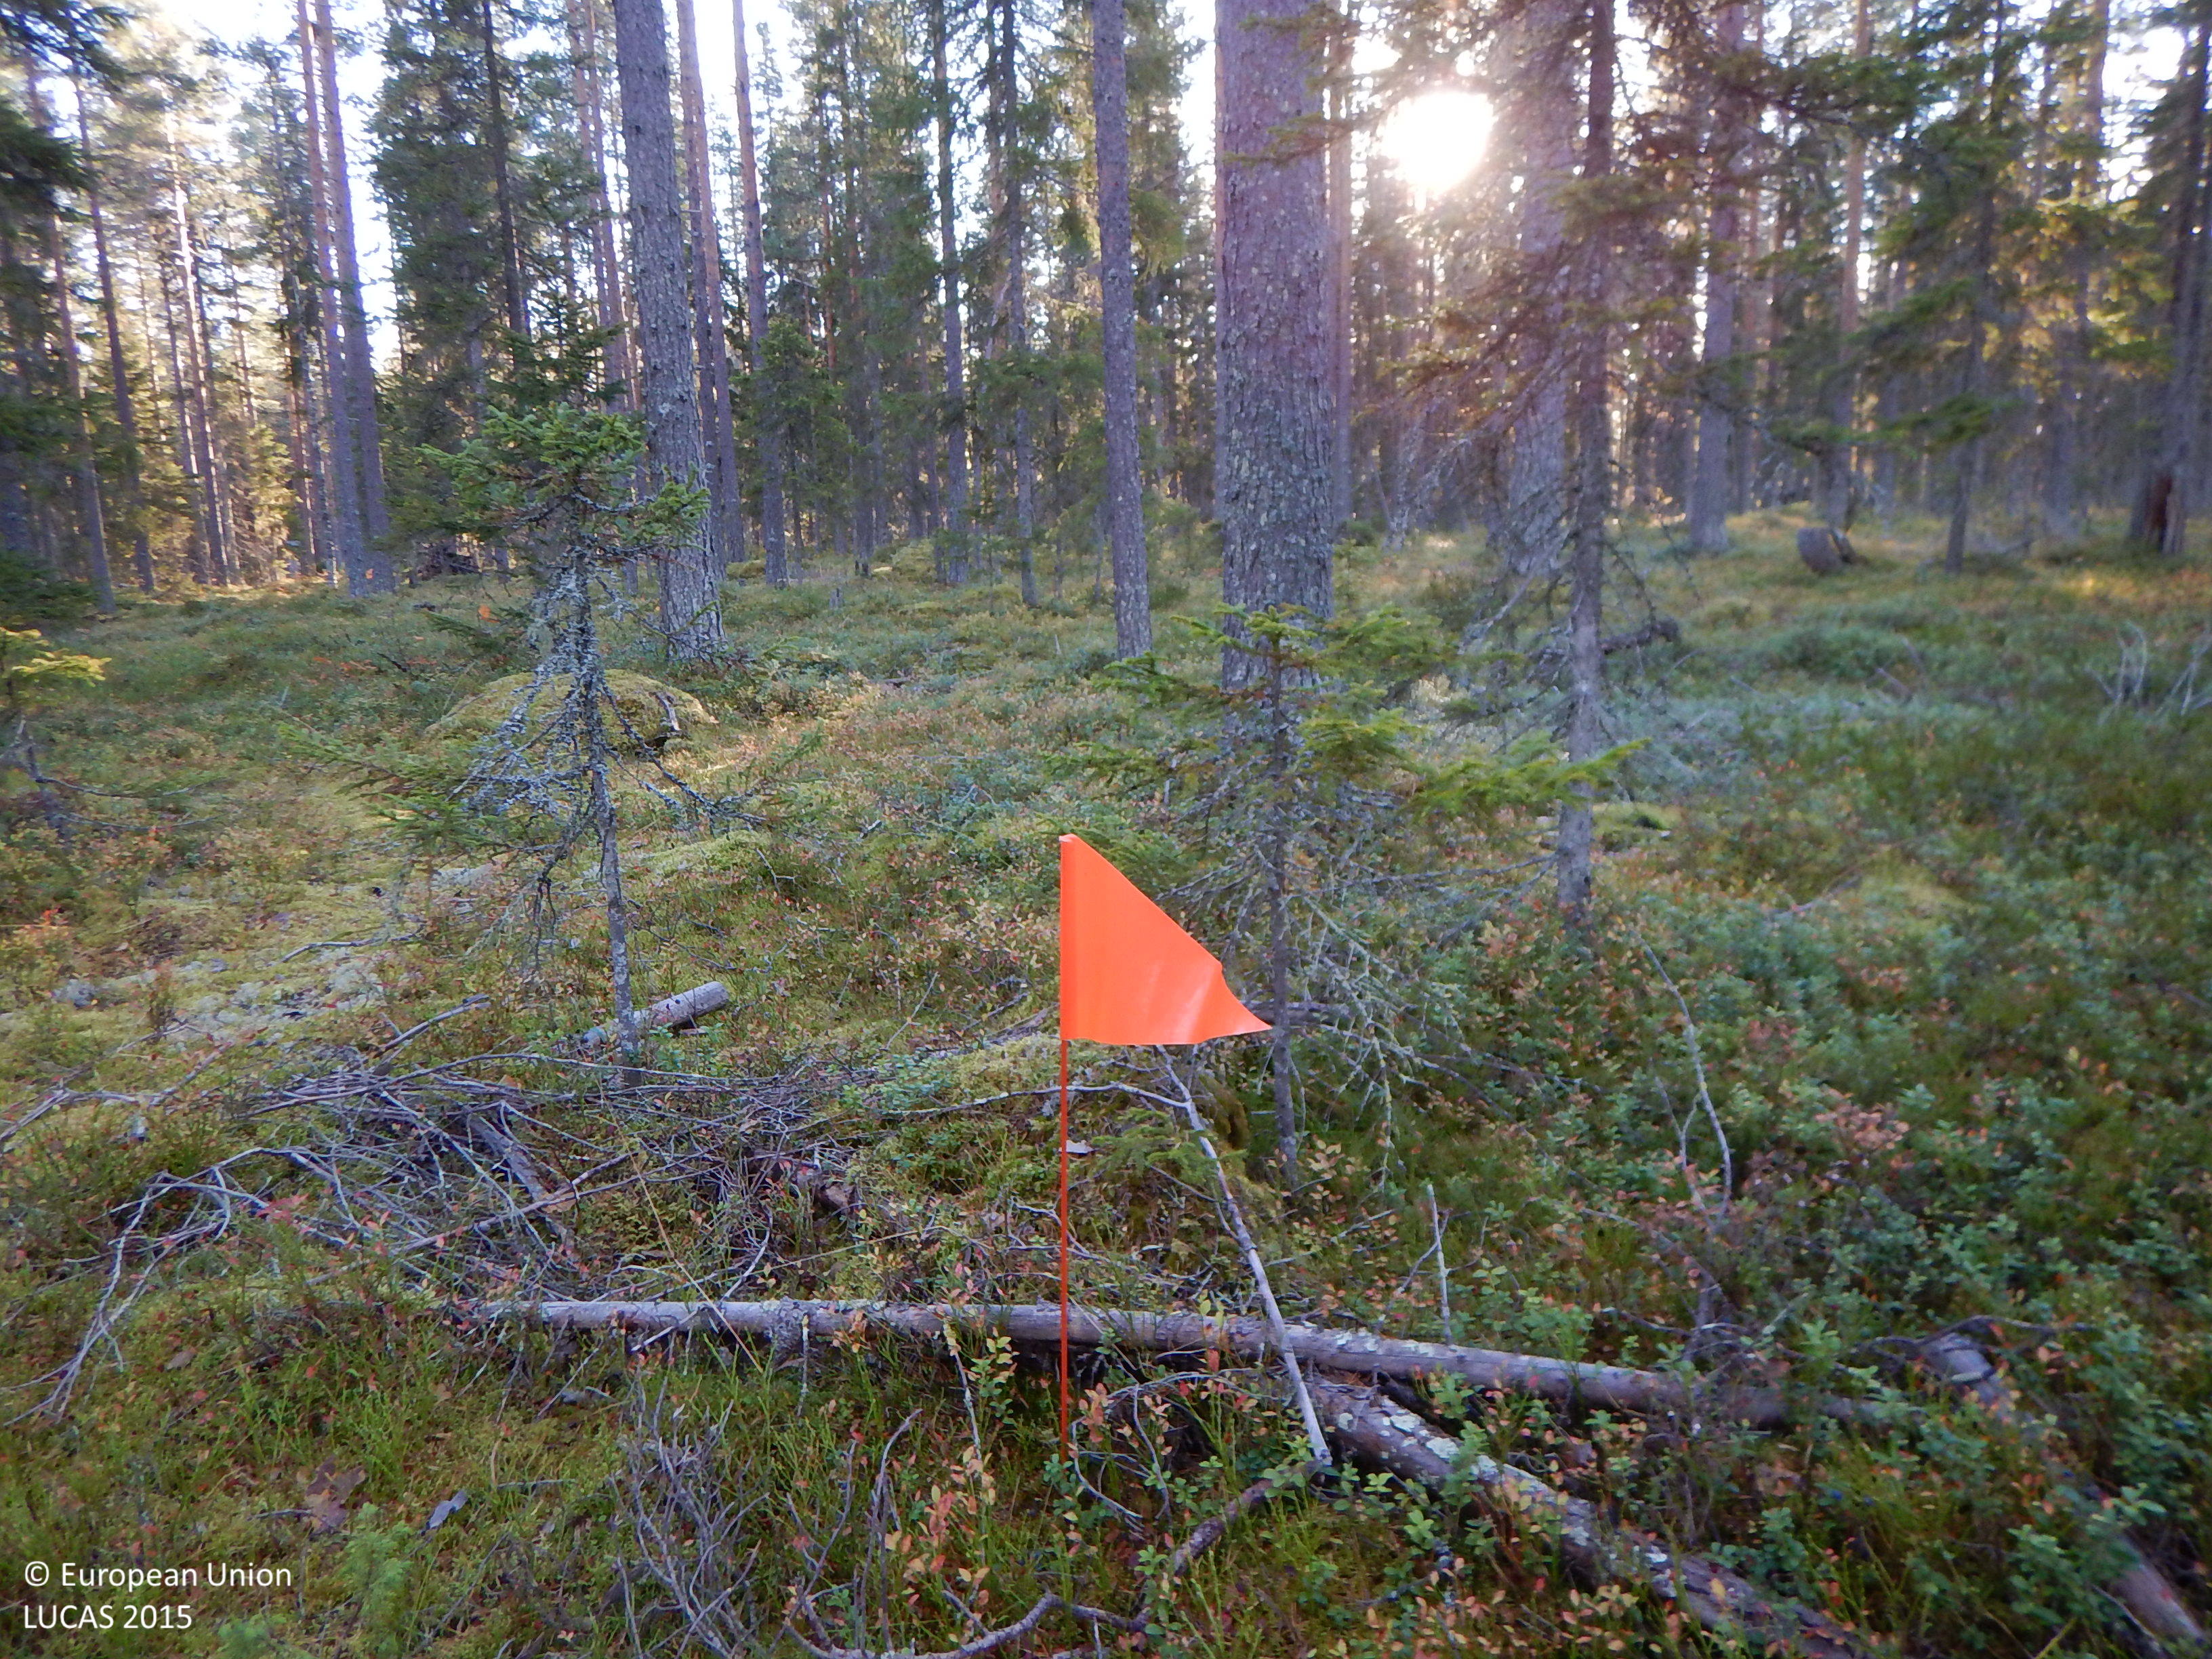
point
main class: Woodland
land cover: Pine dominated coniferous woodland
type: boreal forest
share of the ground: 50 - 75 %
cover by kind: coniferous forest trees 55 %, shrubs 15 %, lichens and mosses 15 %, herbaceous plants 10 %, broadleaved forest trees 5 %
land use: Forestry
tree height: > 5 m
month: October
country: SE
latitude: 65.0412
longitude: 20.9557
